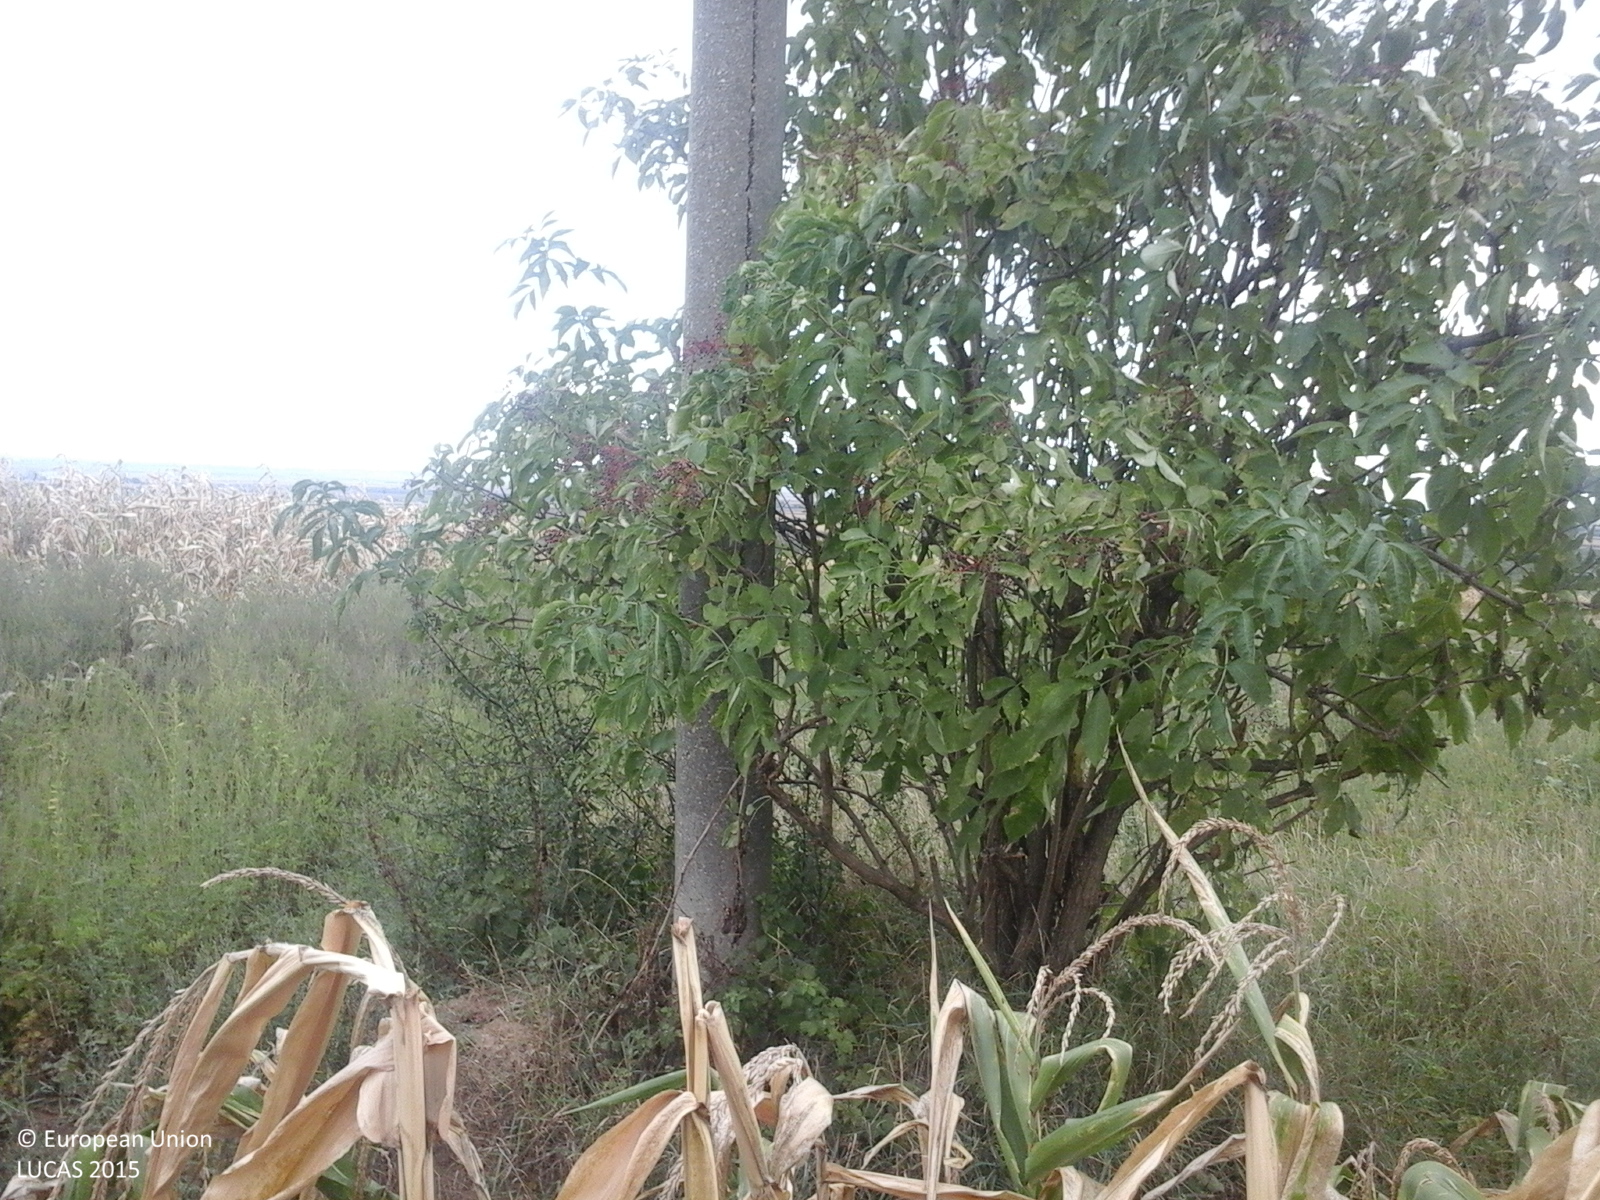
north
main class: Cropland
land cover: Maize
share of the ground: > 75 %
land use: Agriculture (excluding fallow land and kitchen gardens)
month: September
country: RO
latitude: 47.4619
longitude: 22.4326
